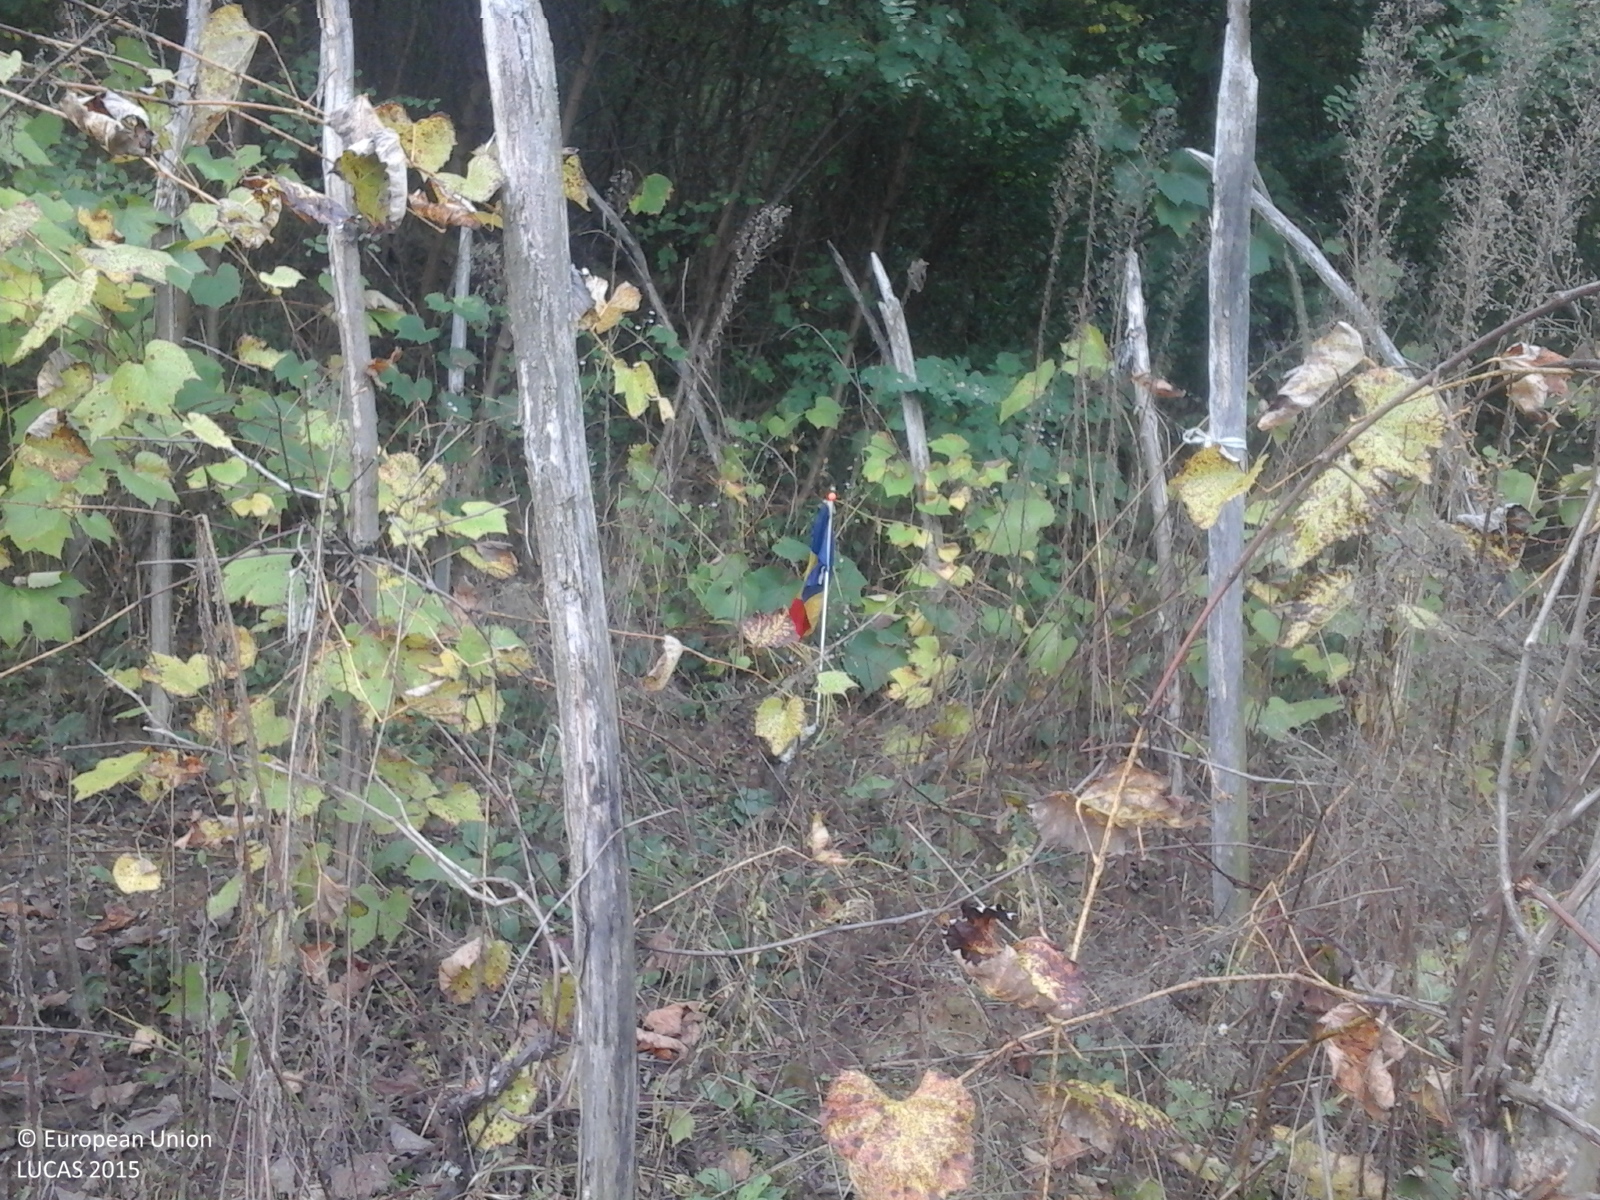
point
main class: Cropland
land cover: Vineyards
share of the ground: 50 - 75 %
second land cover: Spontaneously vegetated surfaces
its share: > 75 %
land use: Agriculture (excluding fallow land and kitchen gardens)
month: October
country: RO
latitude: 46.1320
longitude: 24.0409
